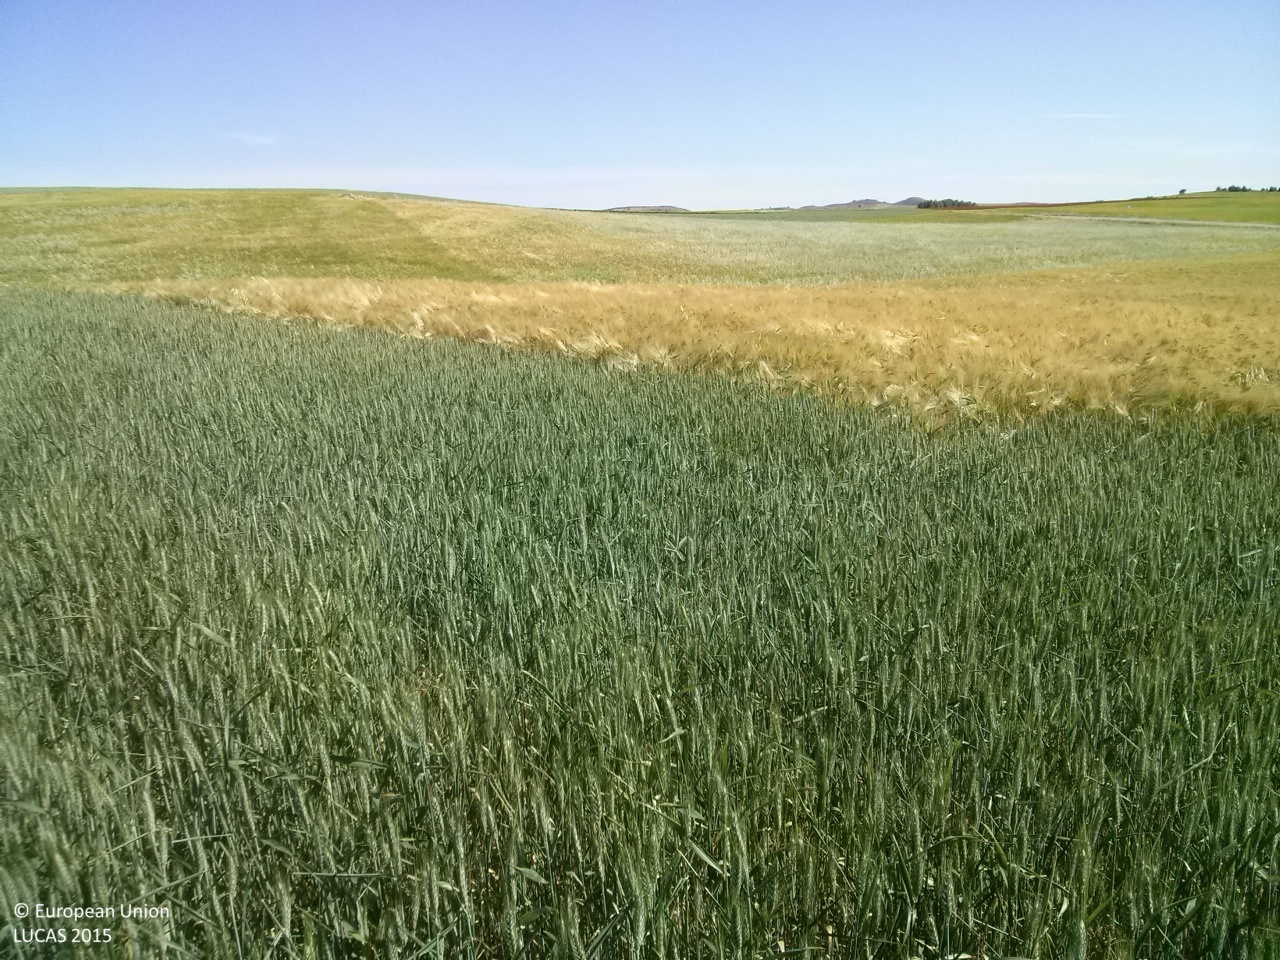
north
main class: Cropland
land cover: Common wheat
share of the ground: > 75 %
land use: Agriculture (excluding fallow land and kitchen gardens)
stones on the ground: < 10 %
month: May
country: ES
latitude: 40.0132
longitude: -2.7796
